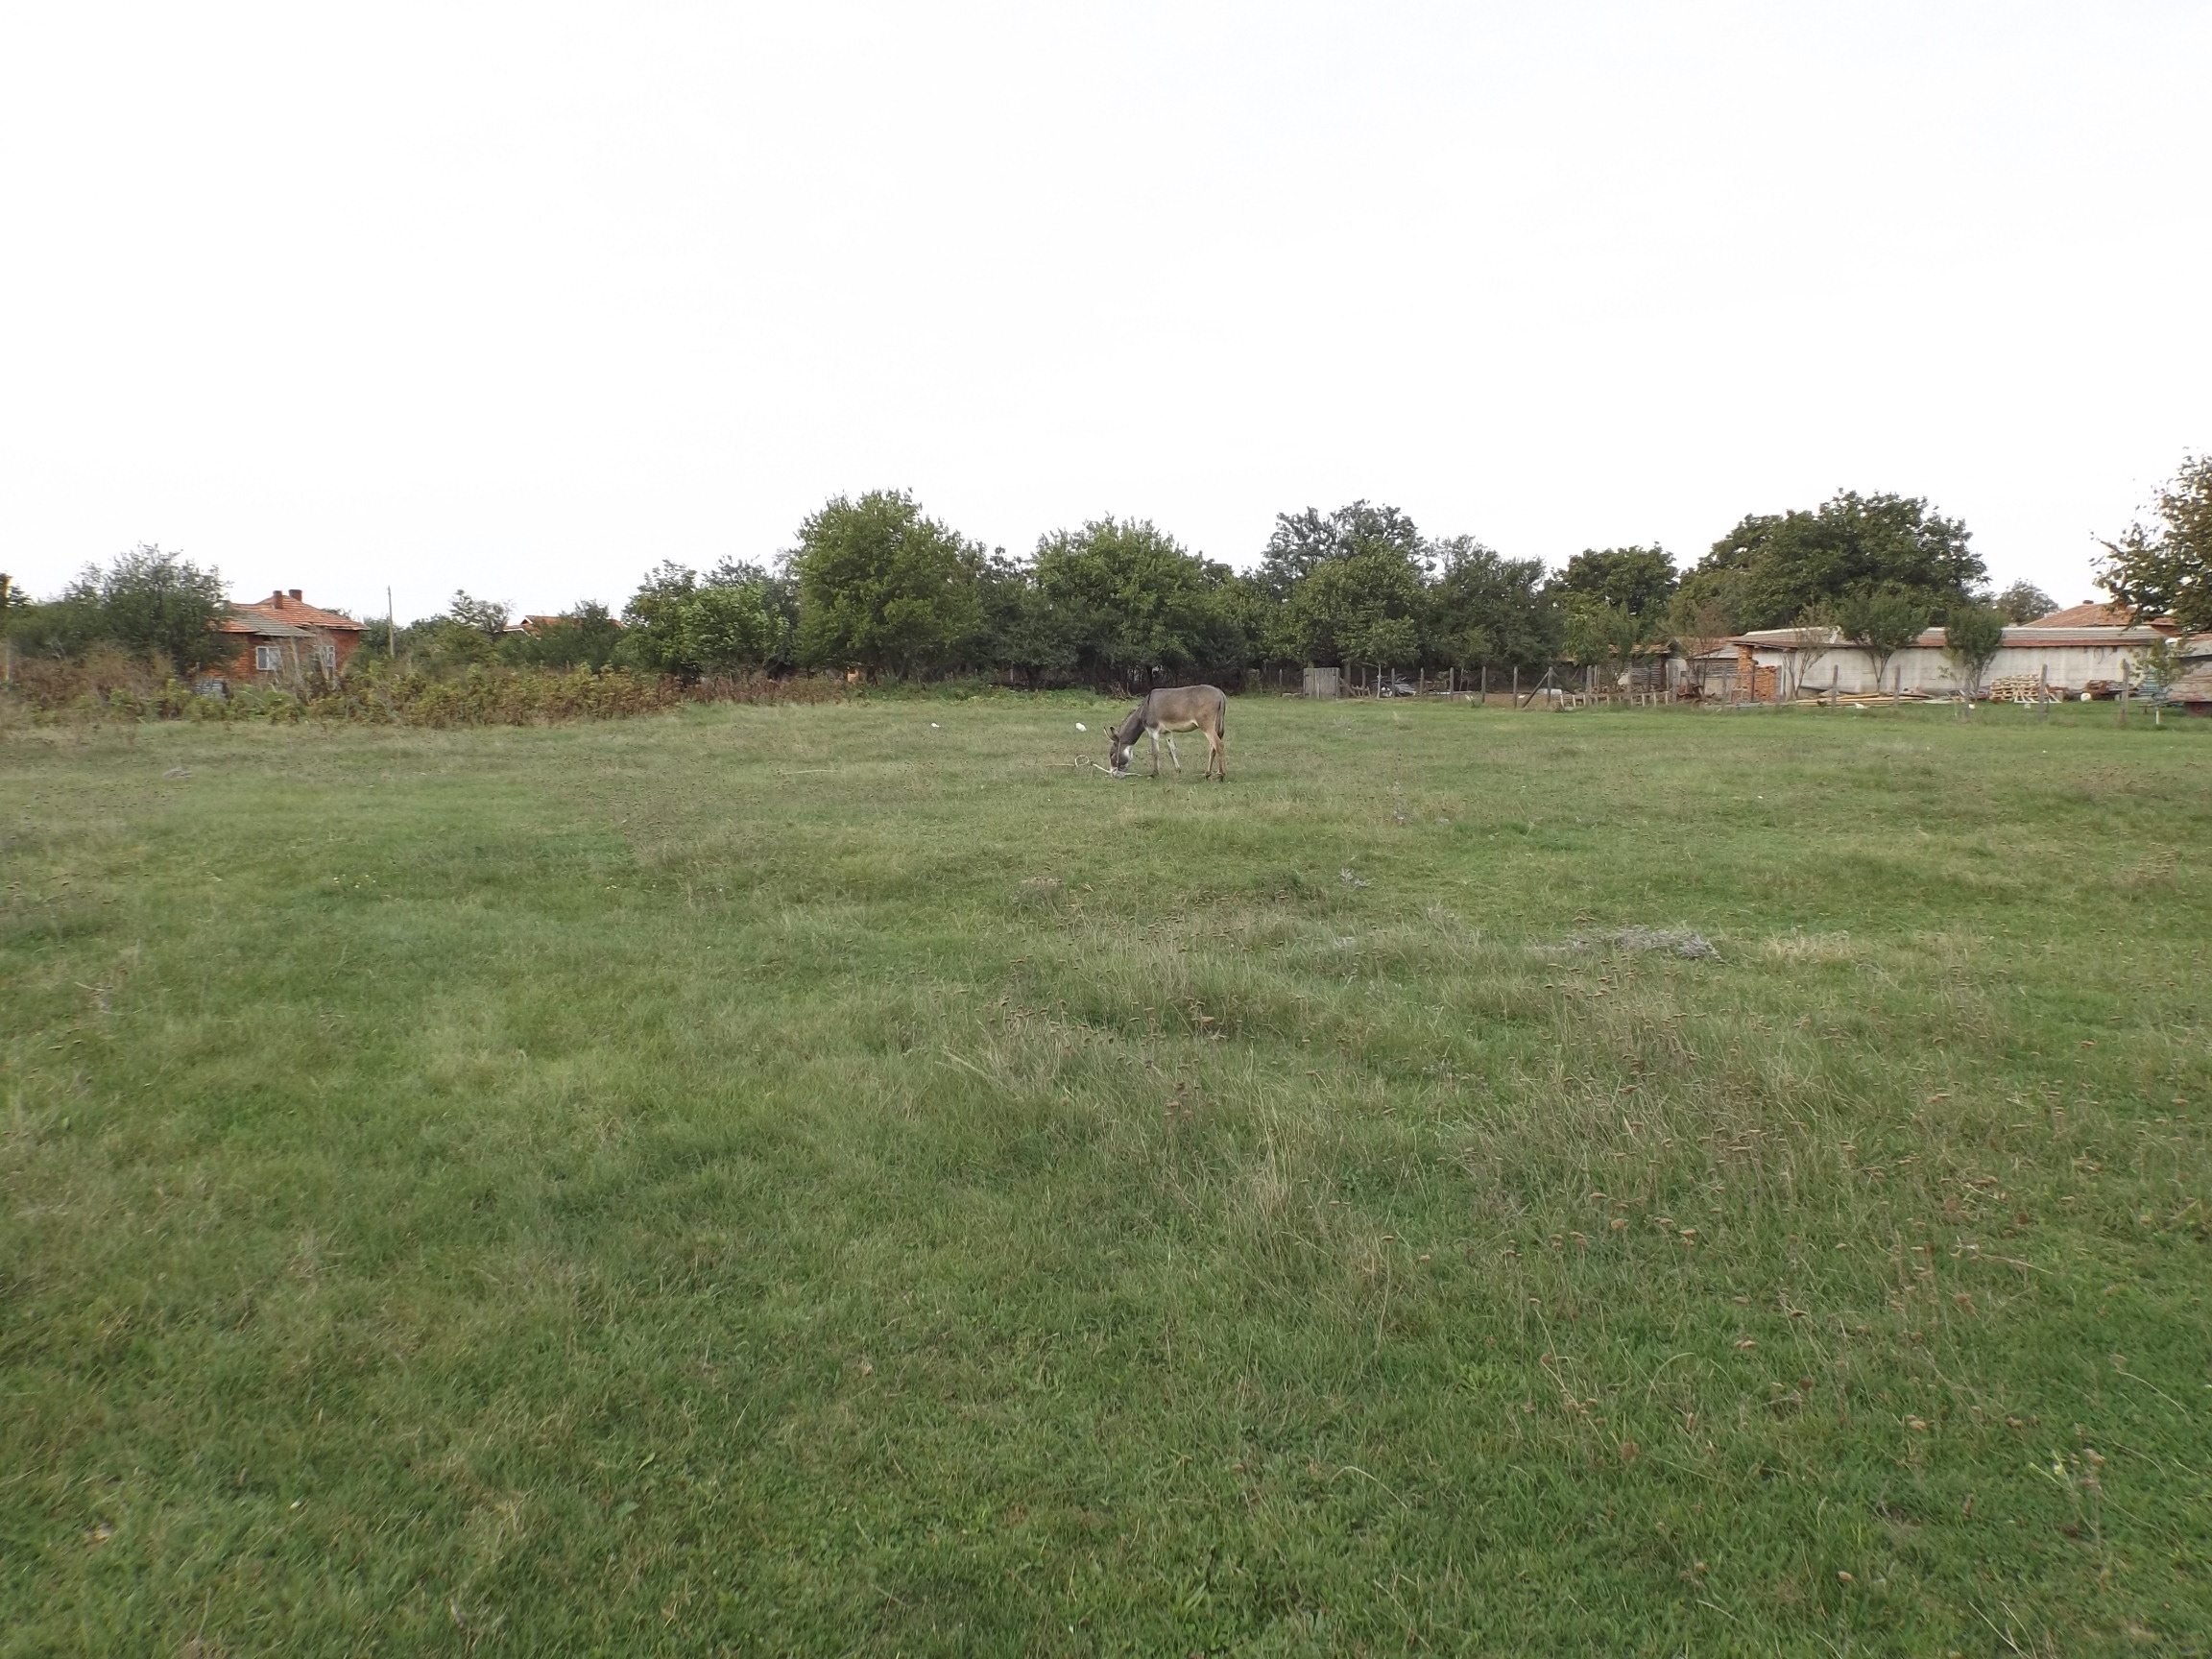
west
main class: Grassland
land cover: Grassland without tree/shrub cover
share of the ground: > 75 %
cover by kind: herbaceous plants 100 %
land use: Agriculture (excluding fallow land and kitchen gardens)
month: October
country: BG
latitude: 43.9141
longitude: 26.8680
